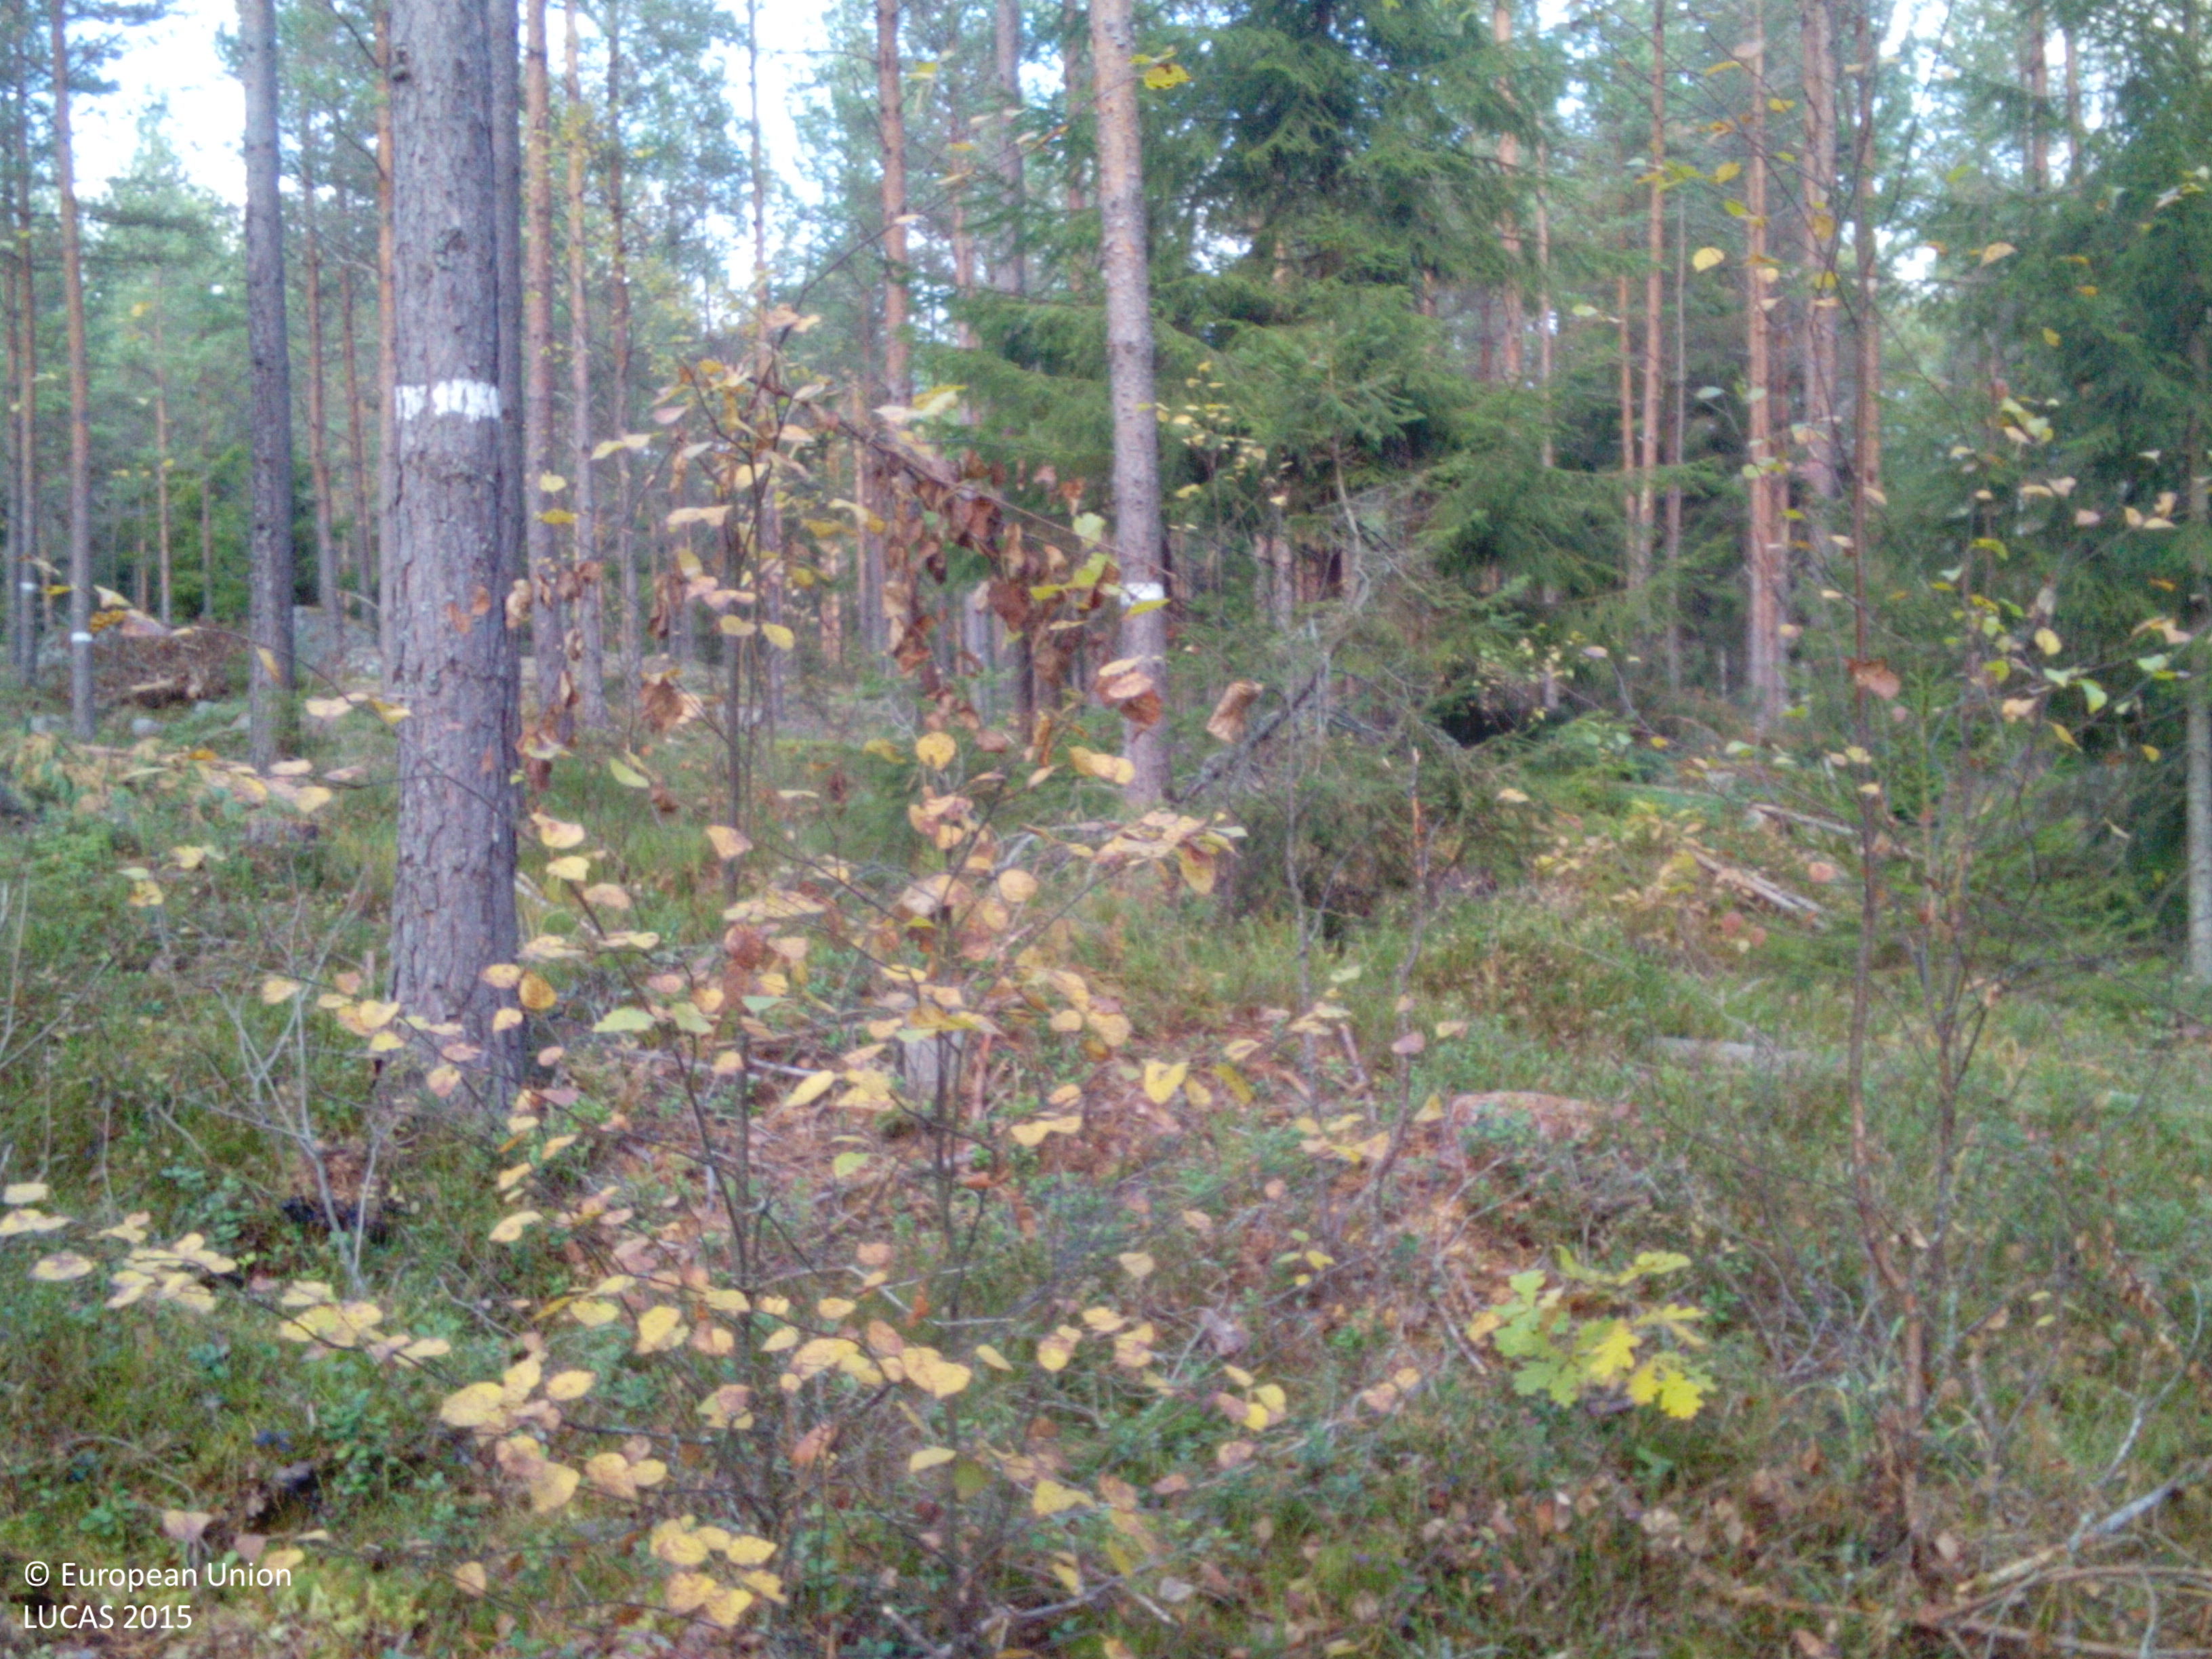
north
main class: Woodland
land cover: Pine dominated coniferous woodland
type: boreal forest
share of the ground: > 75 %
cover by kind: coniferous forest trees 80 %, lichens and mosses 10 %, broadleaved forest trees 5 %, herbaceous plants 5 %
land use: Forestry
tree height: > 5 m
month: October
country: SE
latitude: 58.9935
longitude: 16.2768
